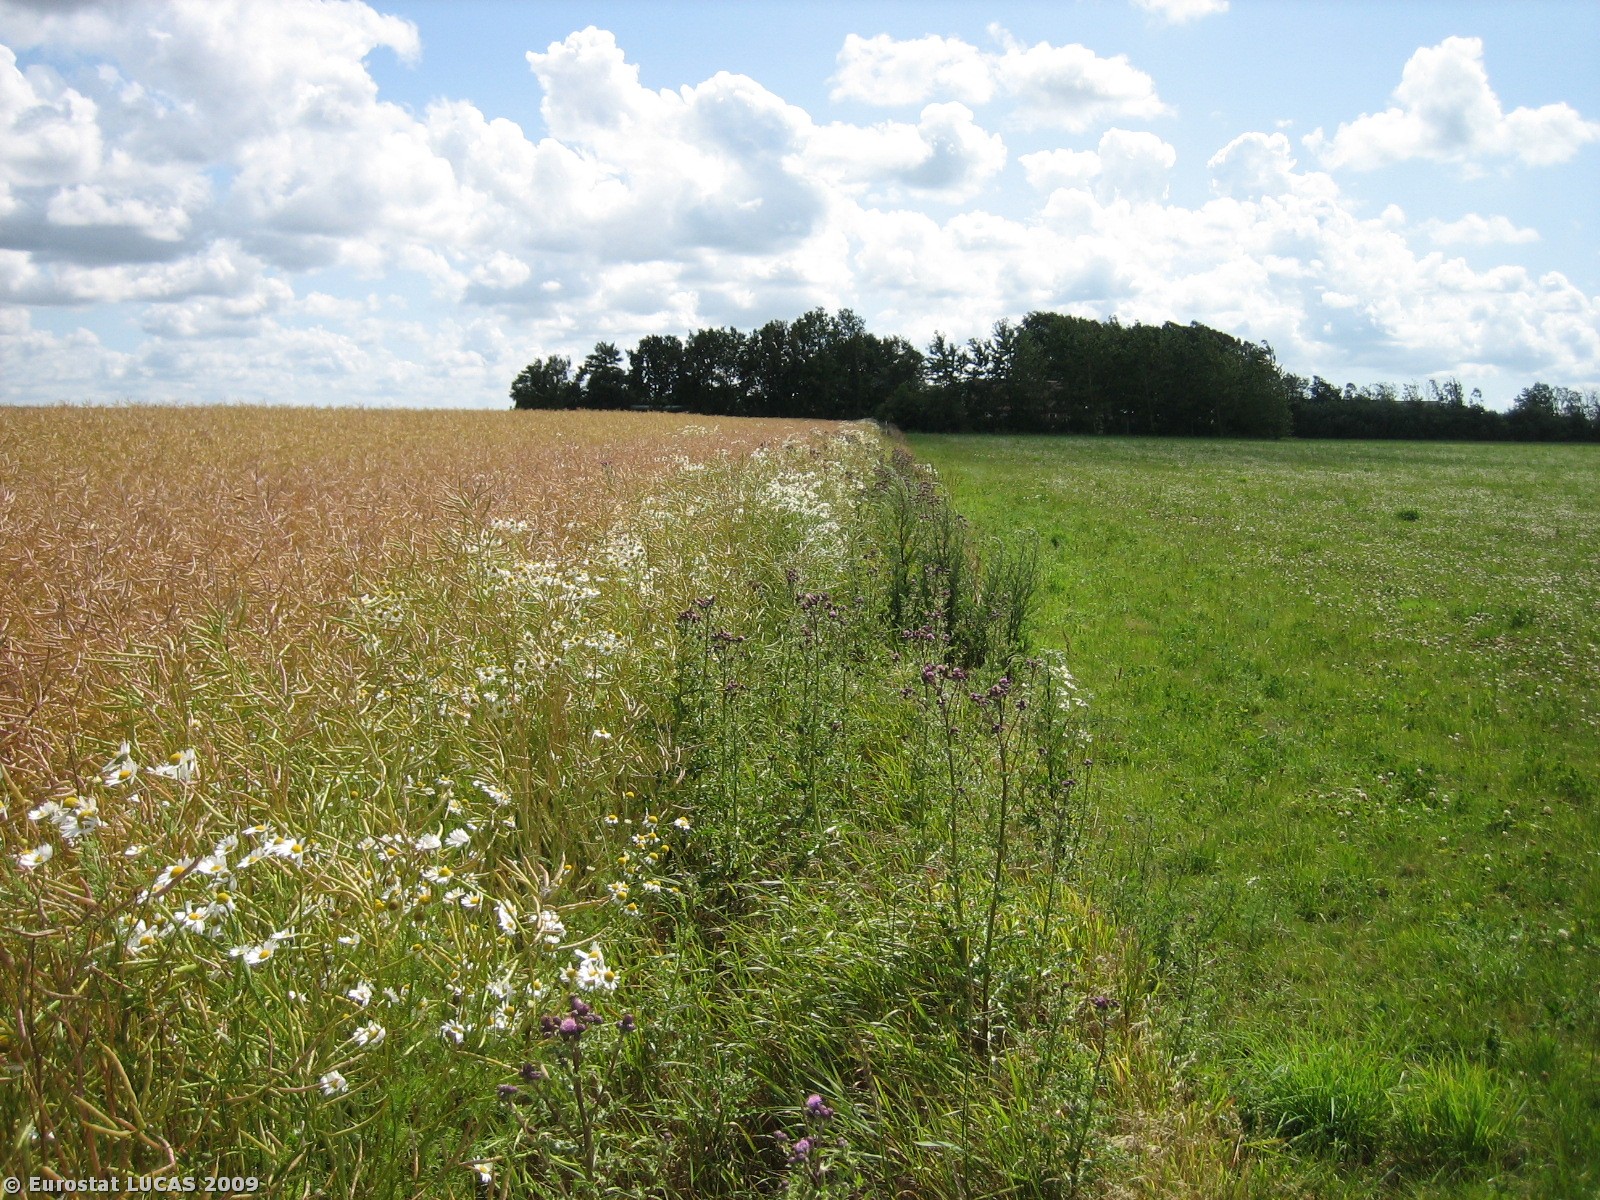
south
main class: Cropland
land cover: Rape and turnip rape
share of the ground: > 75 %
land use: Agriculture (excluding fallow land and kitchen gardens)
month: July
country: DK
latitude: 55.8013
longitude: 8.4860
